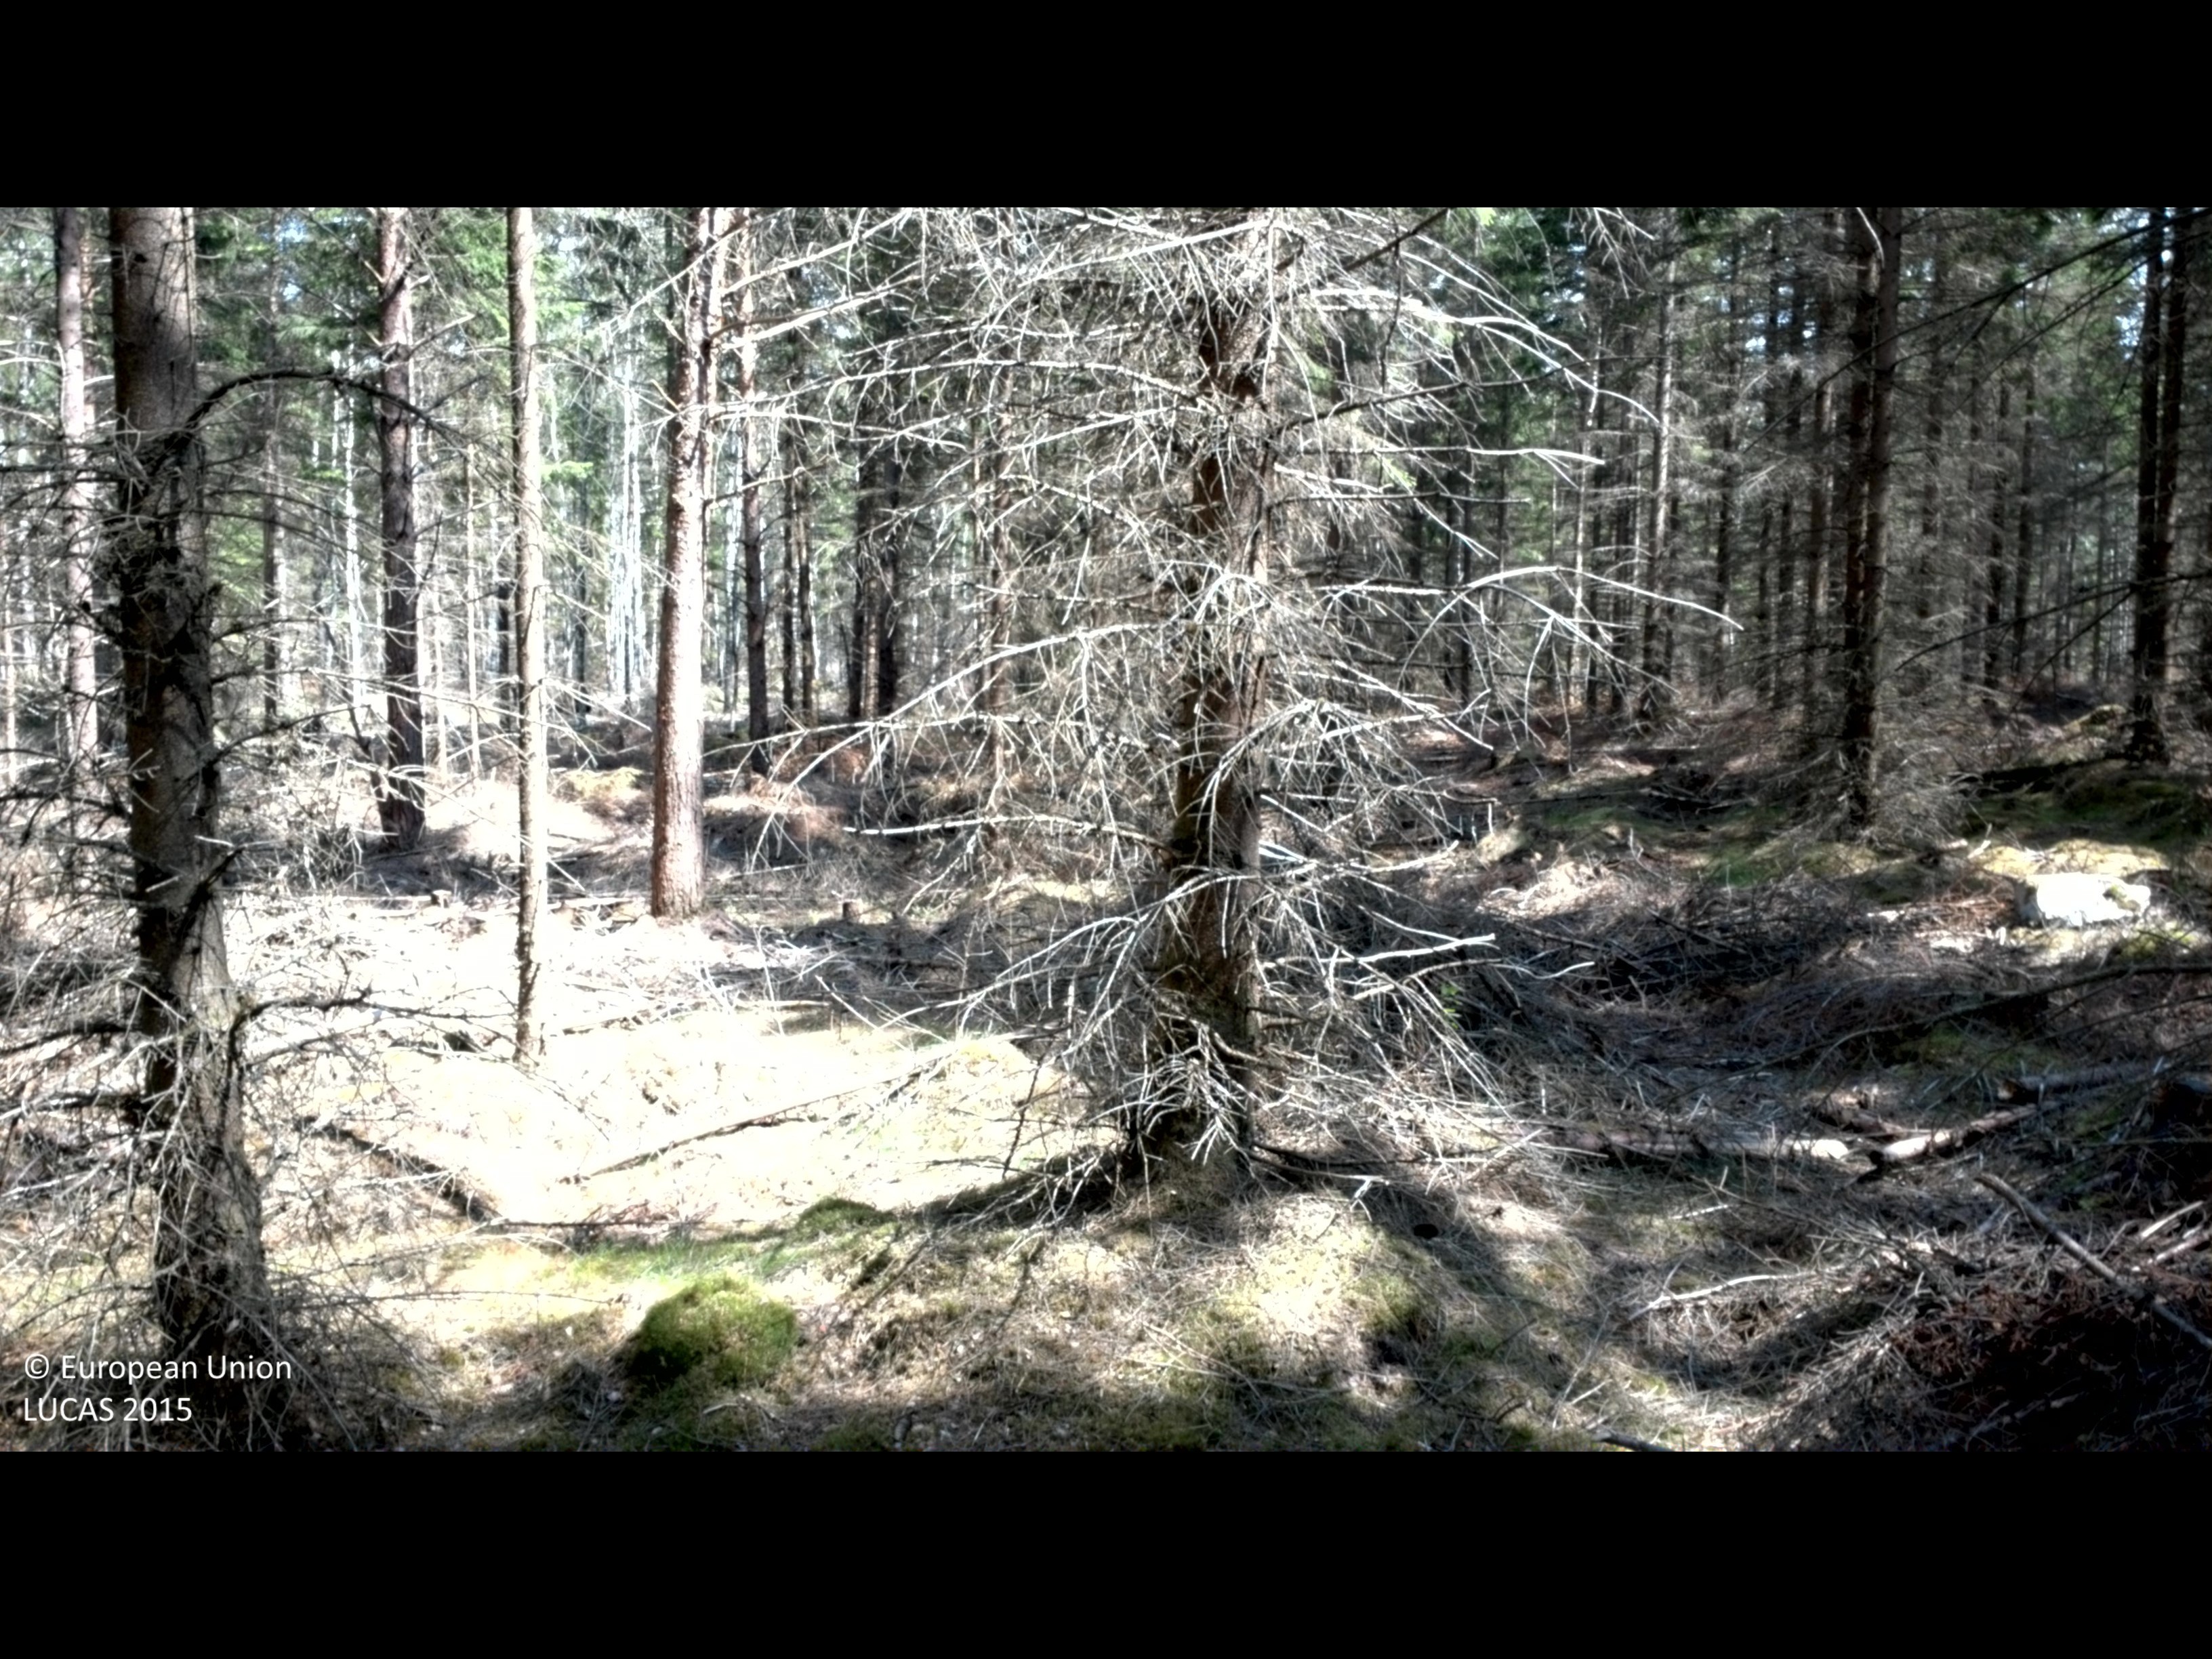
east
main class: Woodland
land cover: Spruce dominated coniferous woodland
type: boreal forest
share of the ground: 50 - 75 %
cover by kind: coniferous forest trees 65 %, lichens and mosses 20 %, unconsolidated bare surface 10 %, broadleaved forest trees 5 %
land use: Forestry
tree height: > 5 m
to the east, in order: Spruce dominated coniferous woodland; Broadleaved woodland; Ditches and canals; Spruce dominated mixed woodland; Spruce dominated coniferous woodland; Paved roads, cycling and walking lanes; Other coniferous woodland
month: July
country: SE
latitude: 56.4411
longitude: 14.2633
